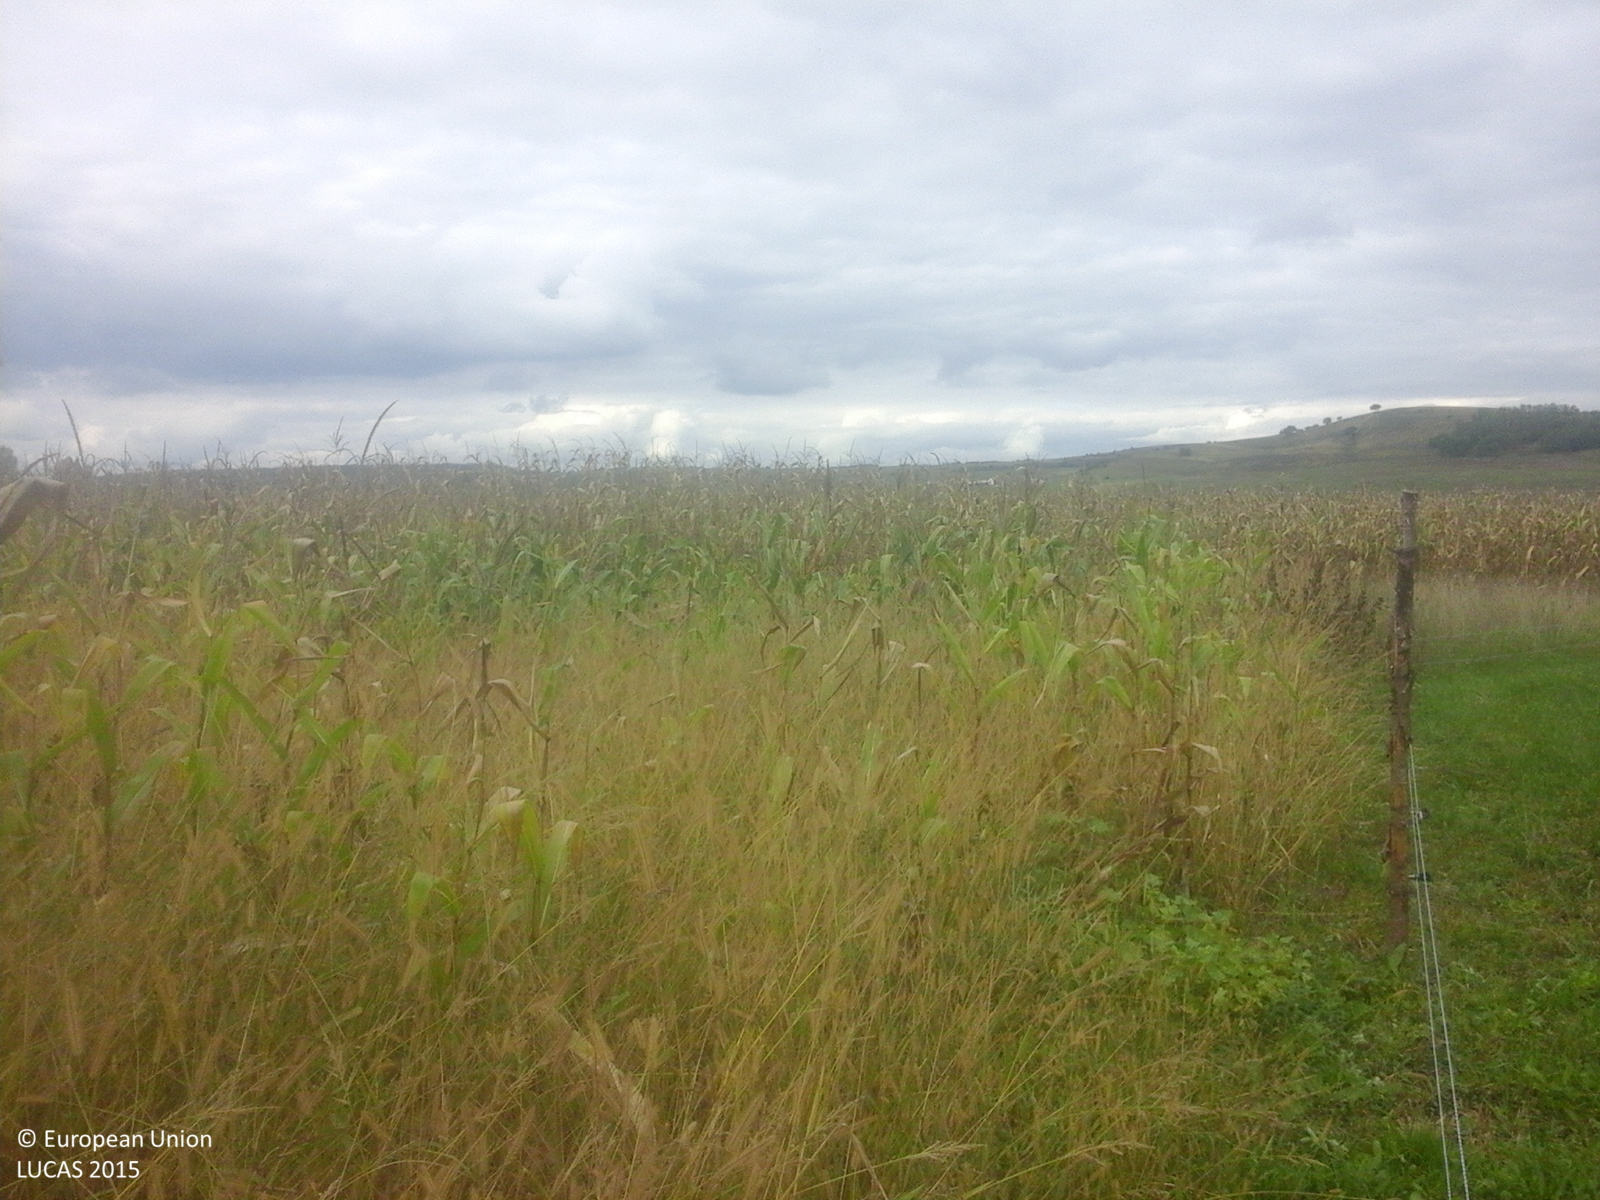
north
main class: Cropland
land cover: Maize
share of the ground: > 75 %
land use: Agriculture (excluding fallow land and kitchen gardens)
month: September
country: RO
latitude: 45.8597
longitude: 23.8906
